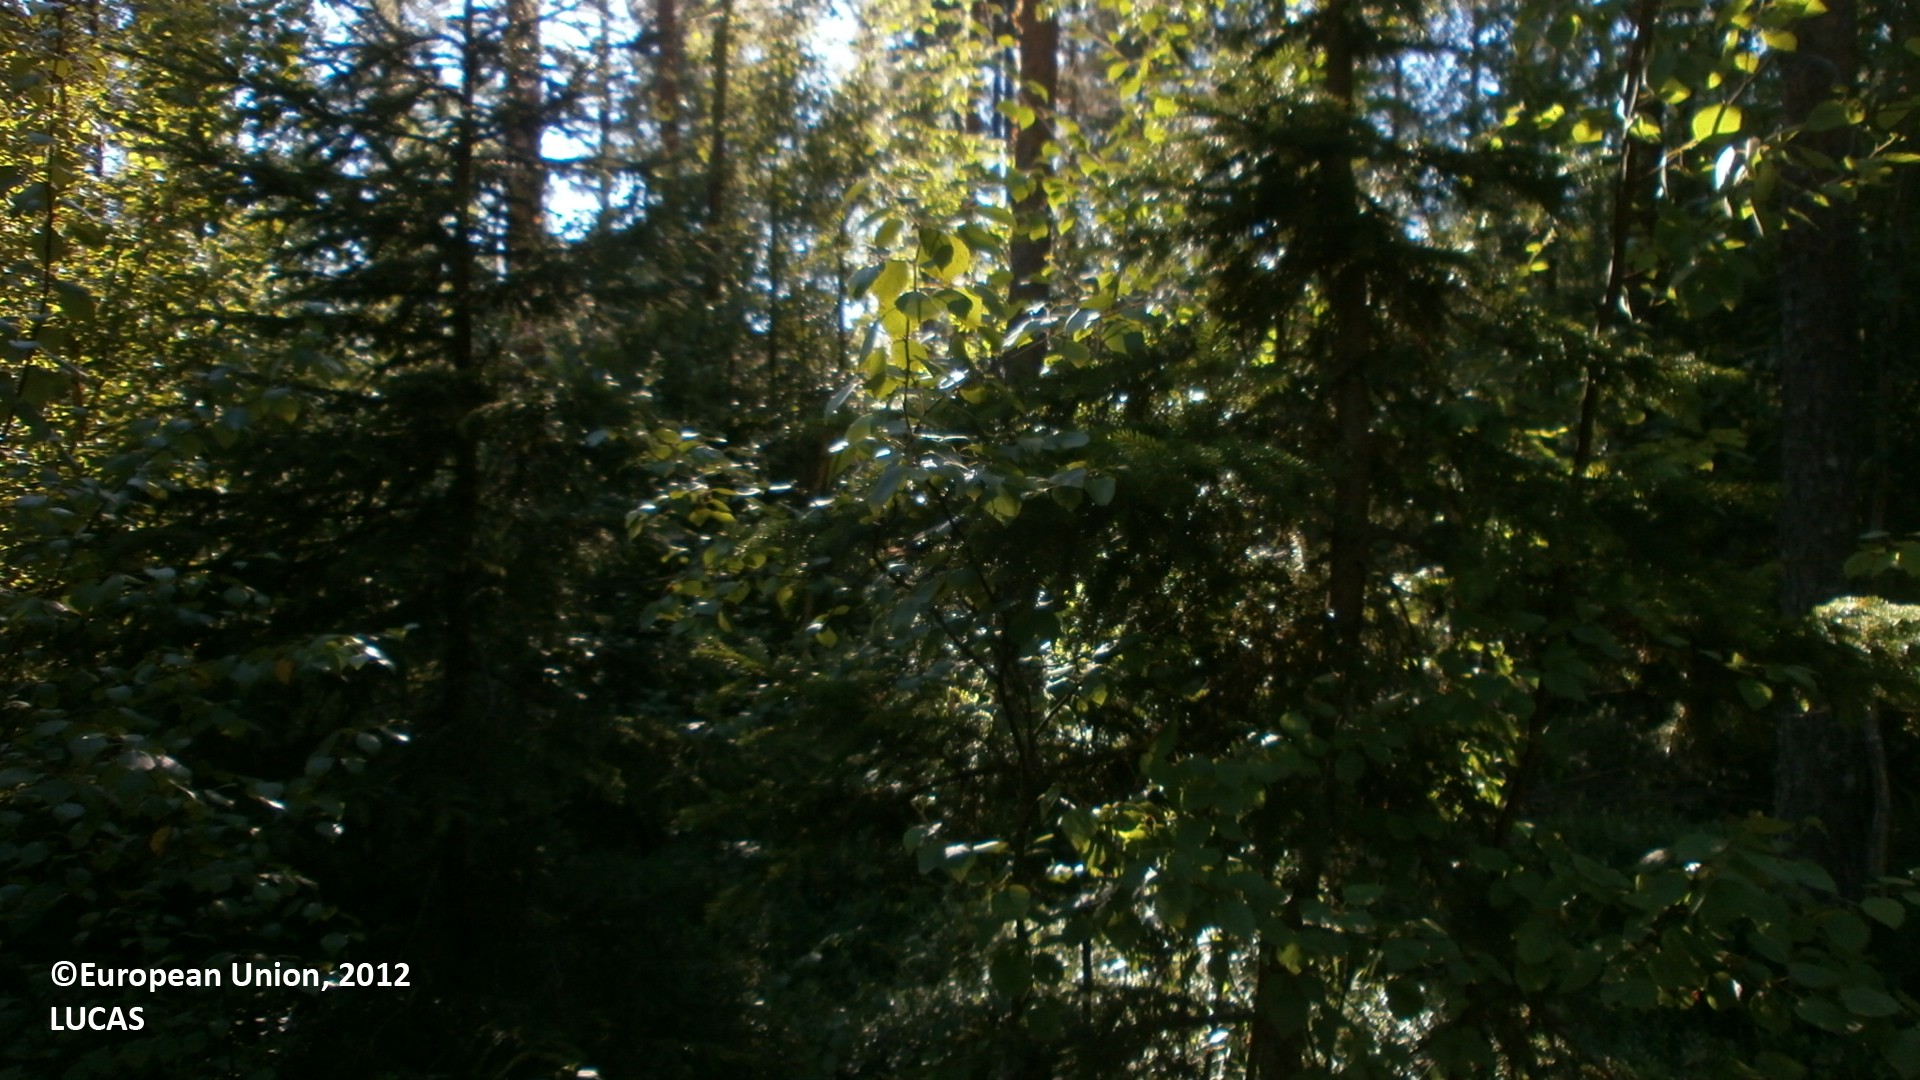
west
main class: Woodland
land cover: Pine dominated coniferous woodland
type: boreal forest
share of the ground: 50 - 75 %
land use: Forestry
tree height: > 5 m
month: July
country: FI
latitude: 64.0344
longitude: 23.9642
